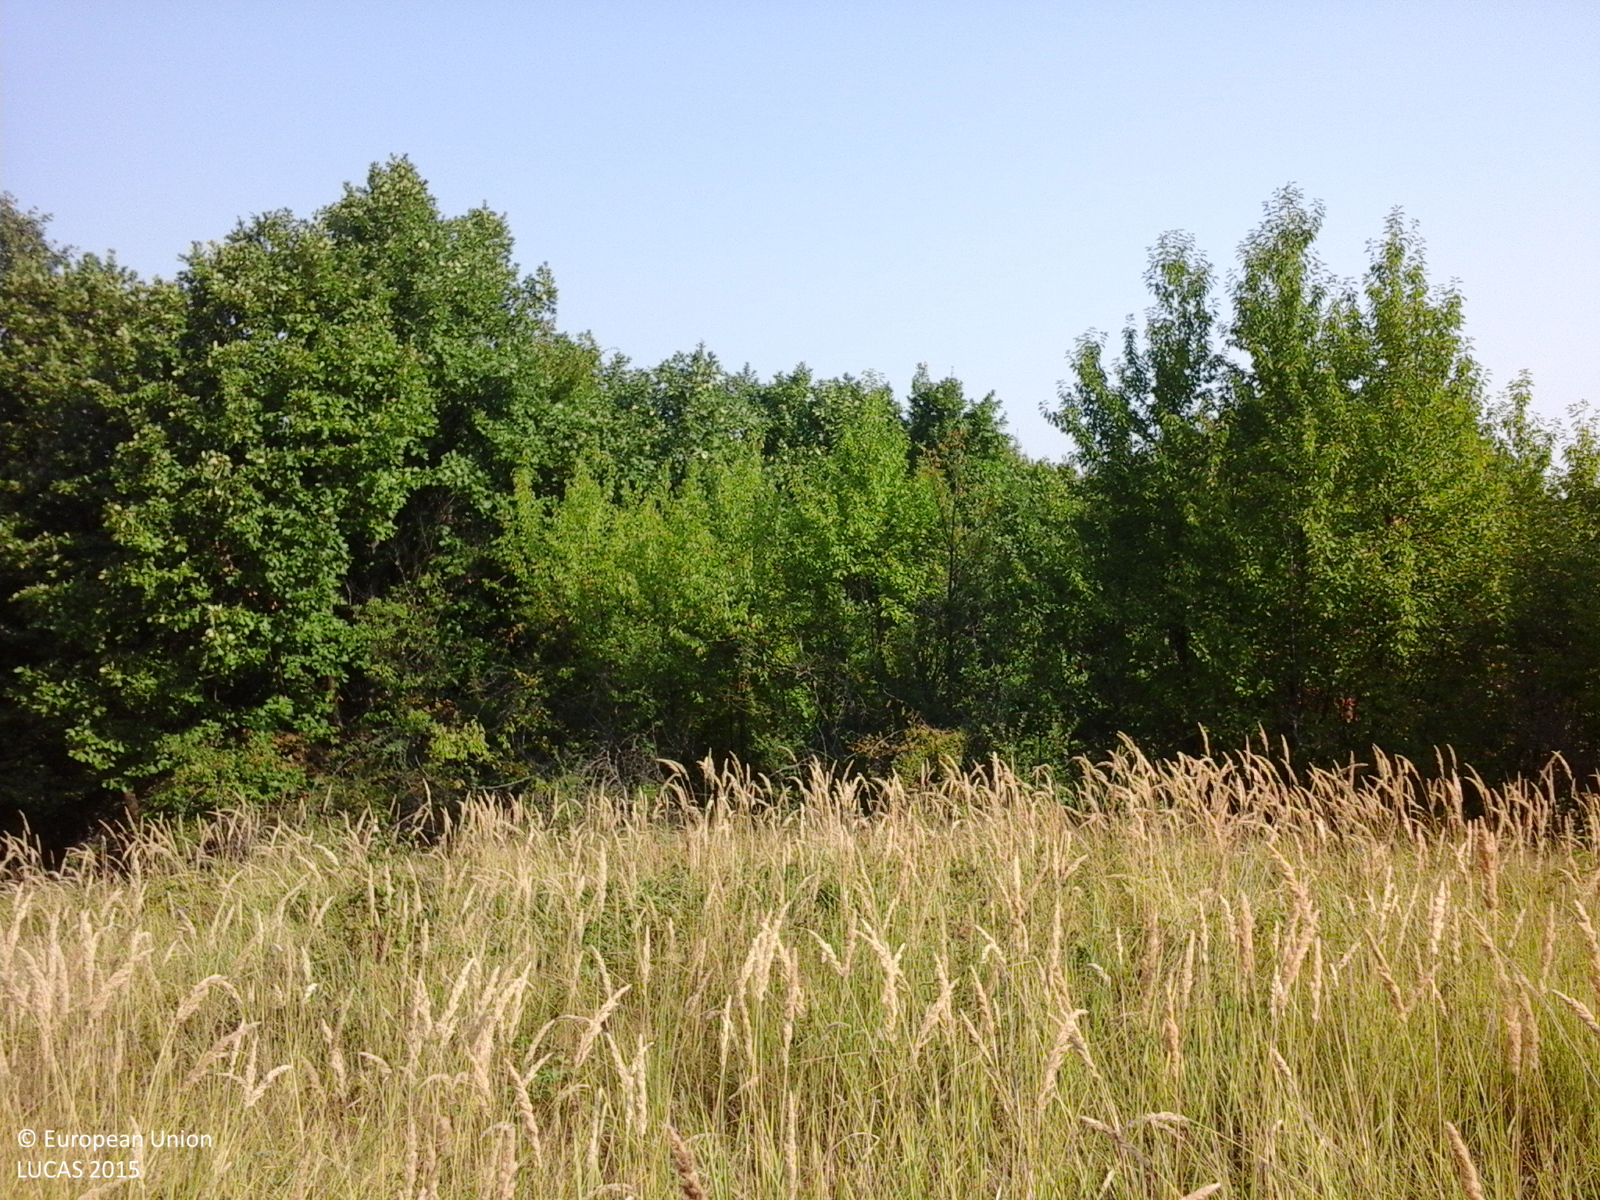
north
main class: Grassland
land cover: Spontaneously vegetated surfaces
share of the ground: > 75 %
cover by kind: herbaceous plants 100 %
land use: Semi-natural and natural areas not in use
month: August
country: RO
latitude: 46.2802
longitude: 22.1011
